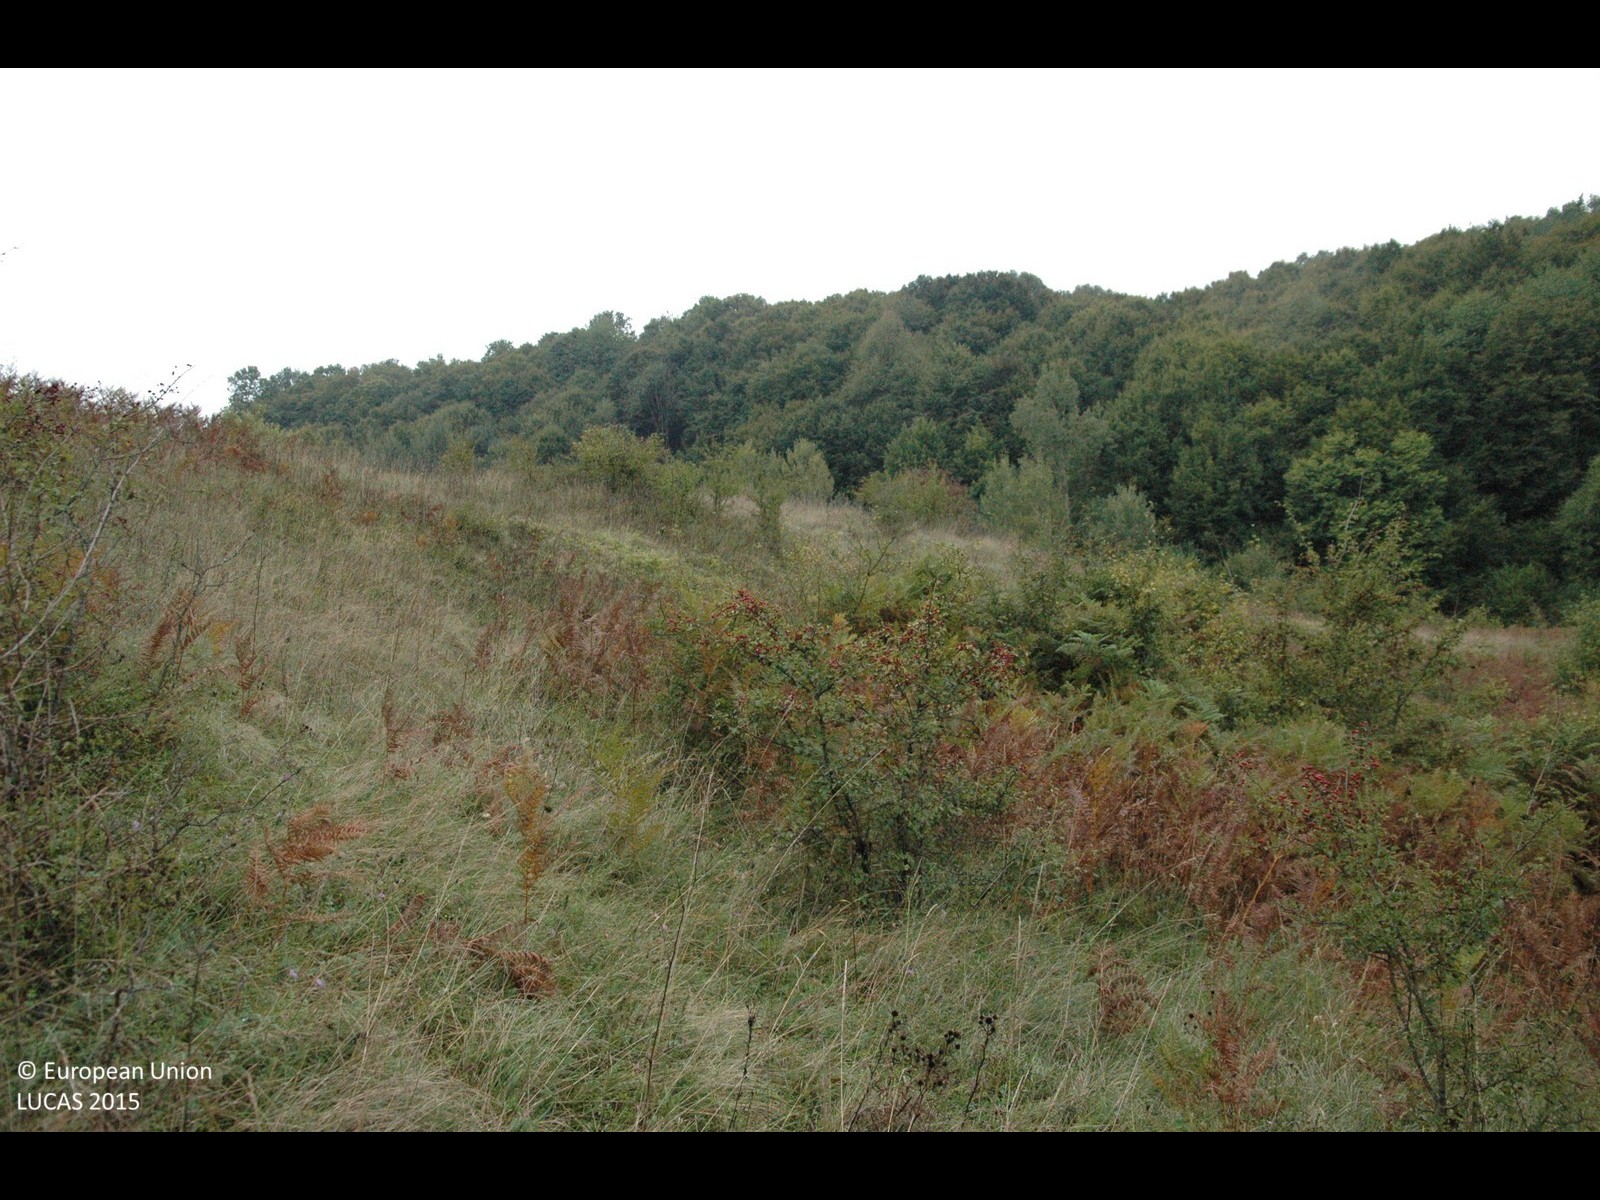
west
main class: Grassland
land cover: Grassland without tree/shrub cover
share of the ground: > 75 %
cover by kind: herbaceous plants 100 %
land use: Semi-natural and natural areas not in use
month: September
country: HR
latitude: 45.0463
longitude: 15.6449
